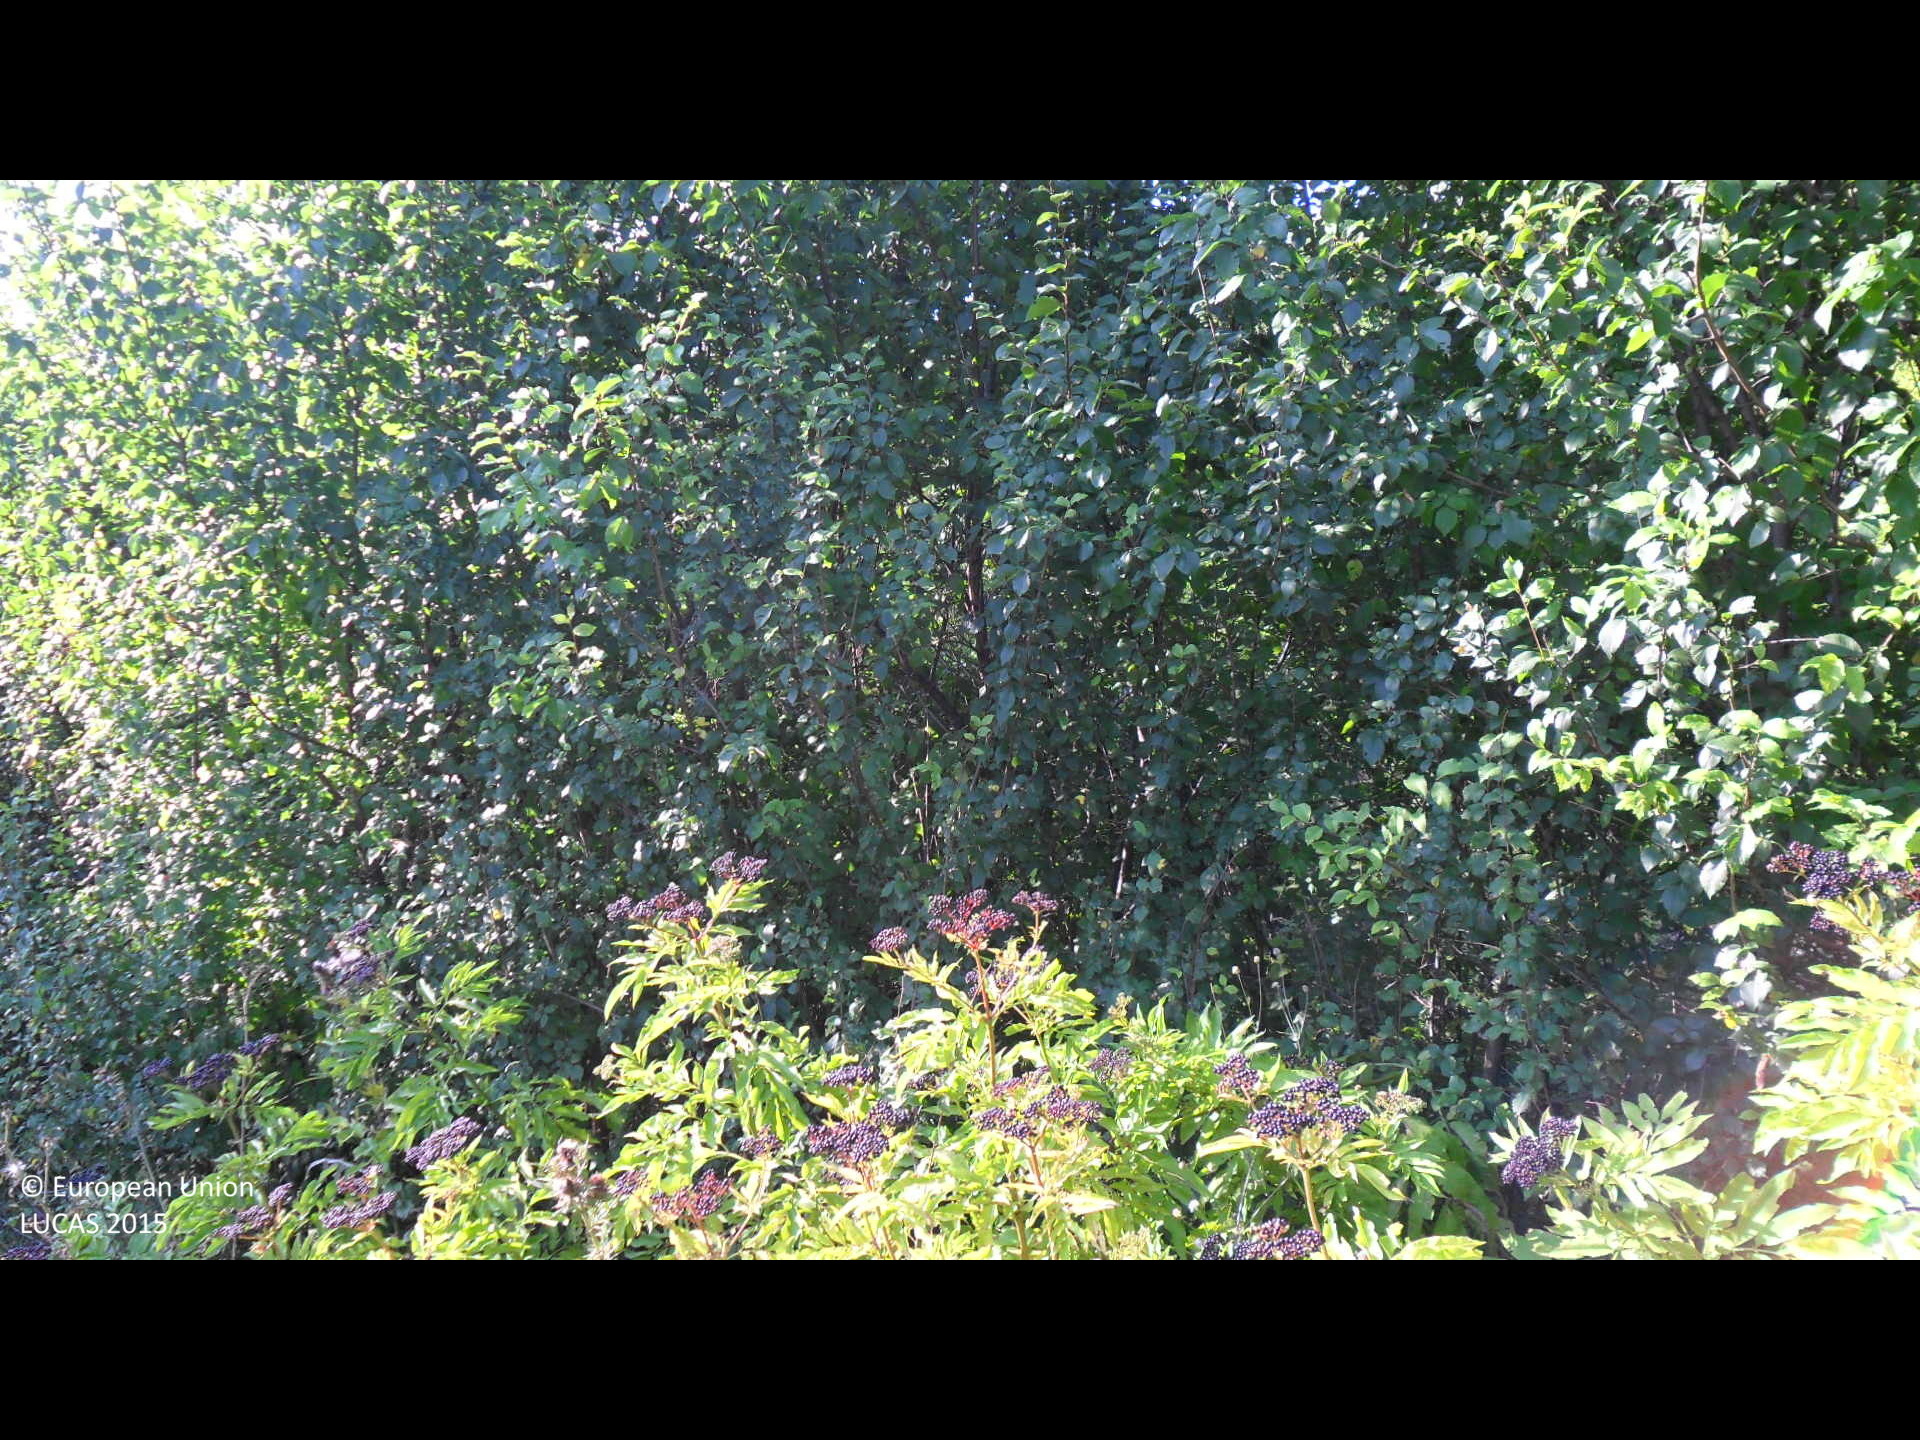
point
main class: Woodland
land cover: Broadleaved woodland
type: mesophytic deciduous forest
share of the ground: > 75 %
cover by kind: broadleaved forest trees 100 %
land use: Forestry
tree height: > 5 m
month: August
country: BG
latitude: 43.1816
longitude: 26.6269
